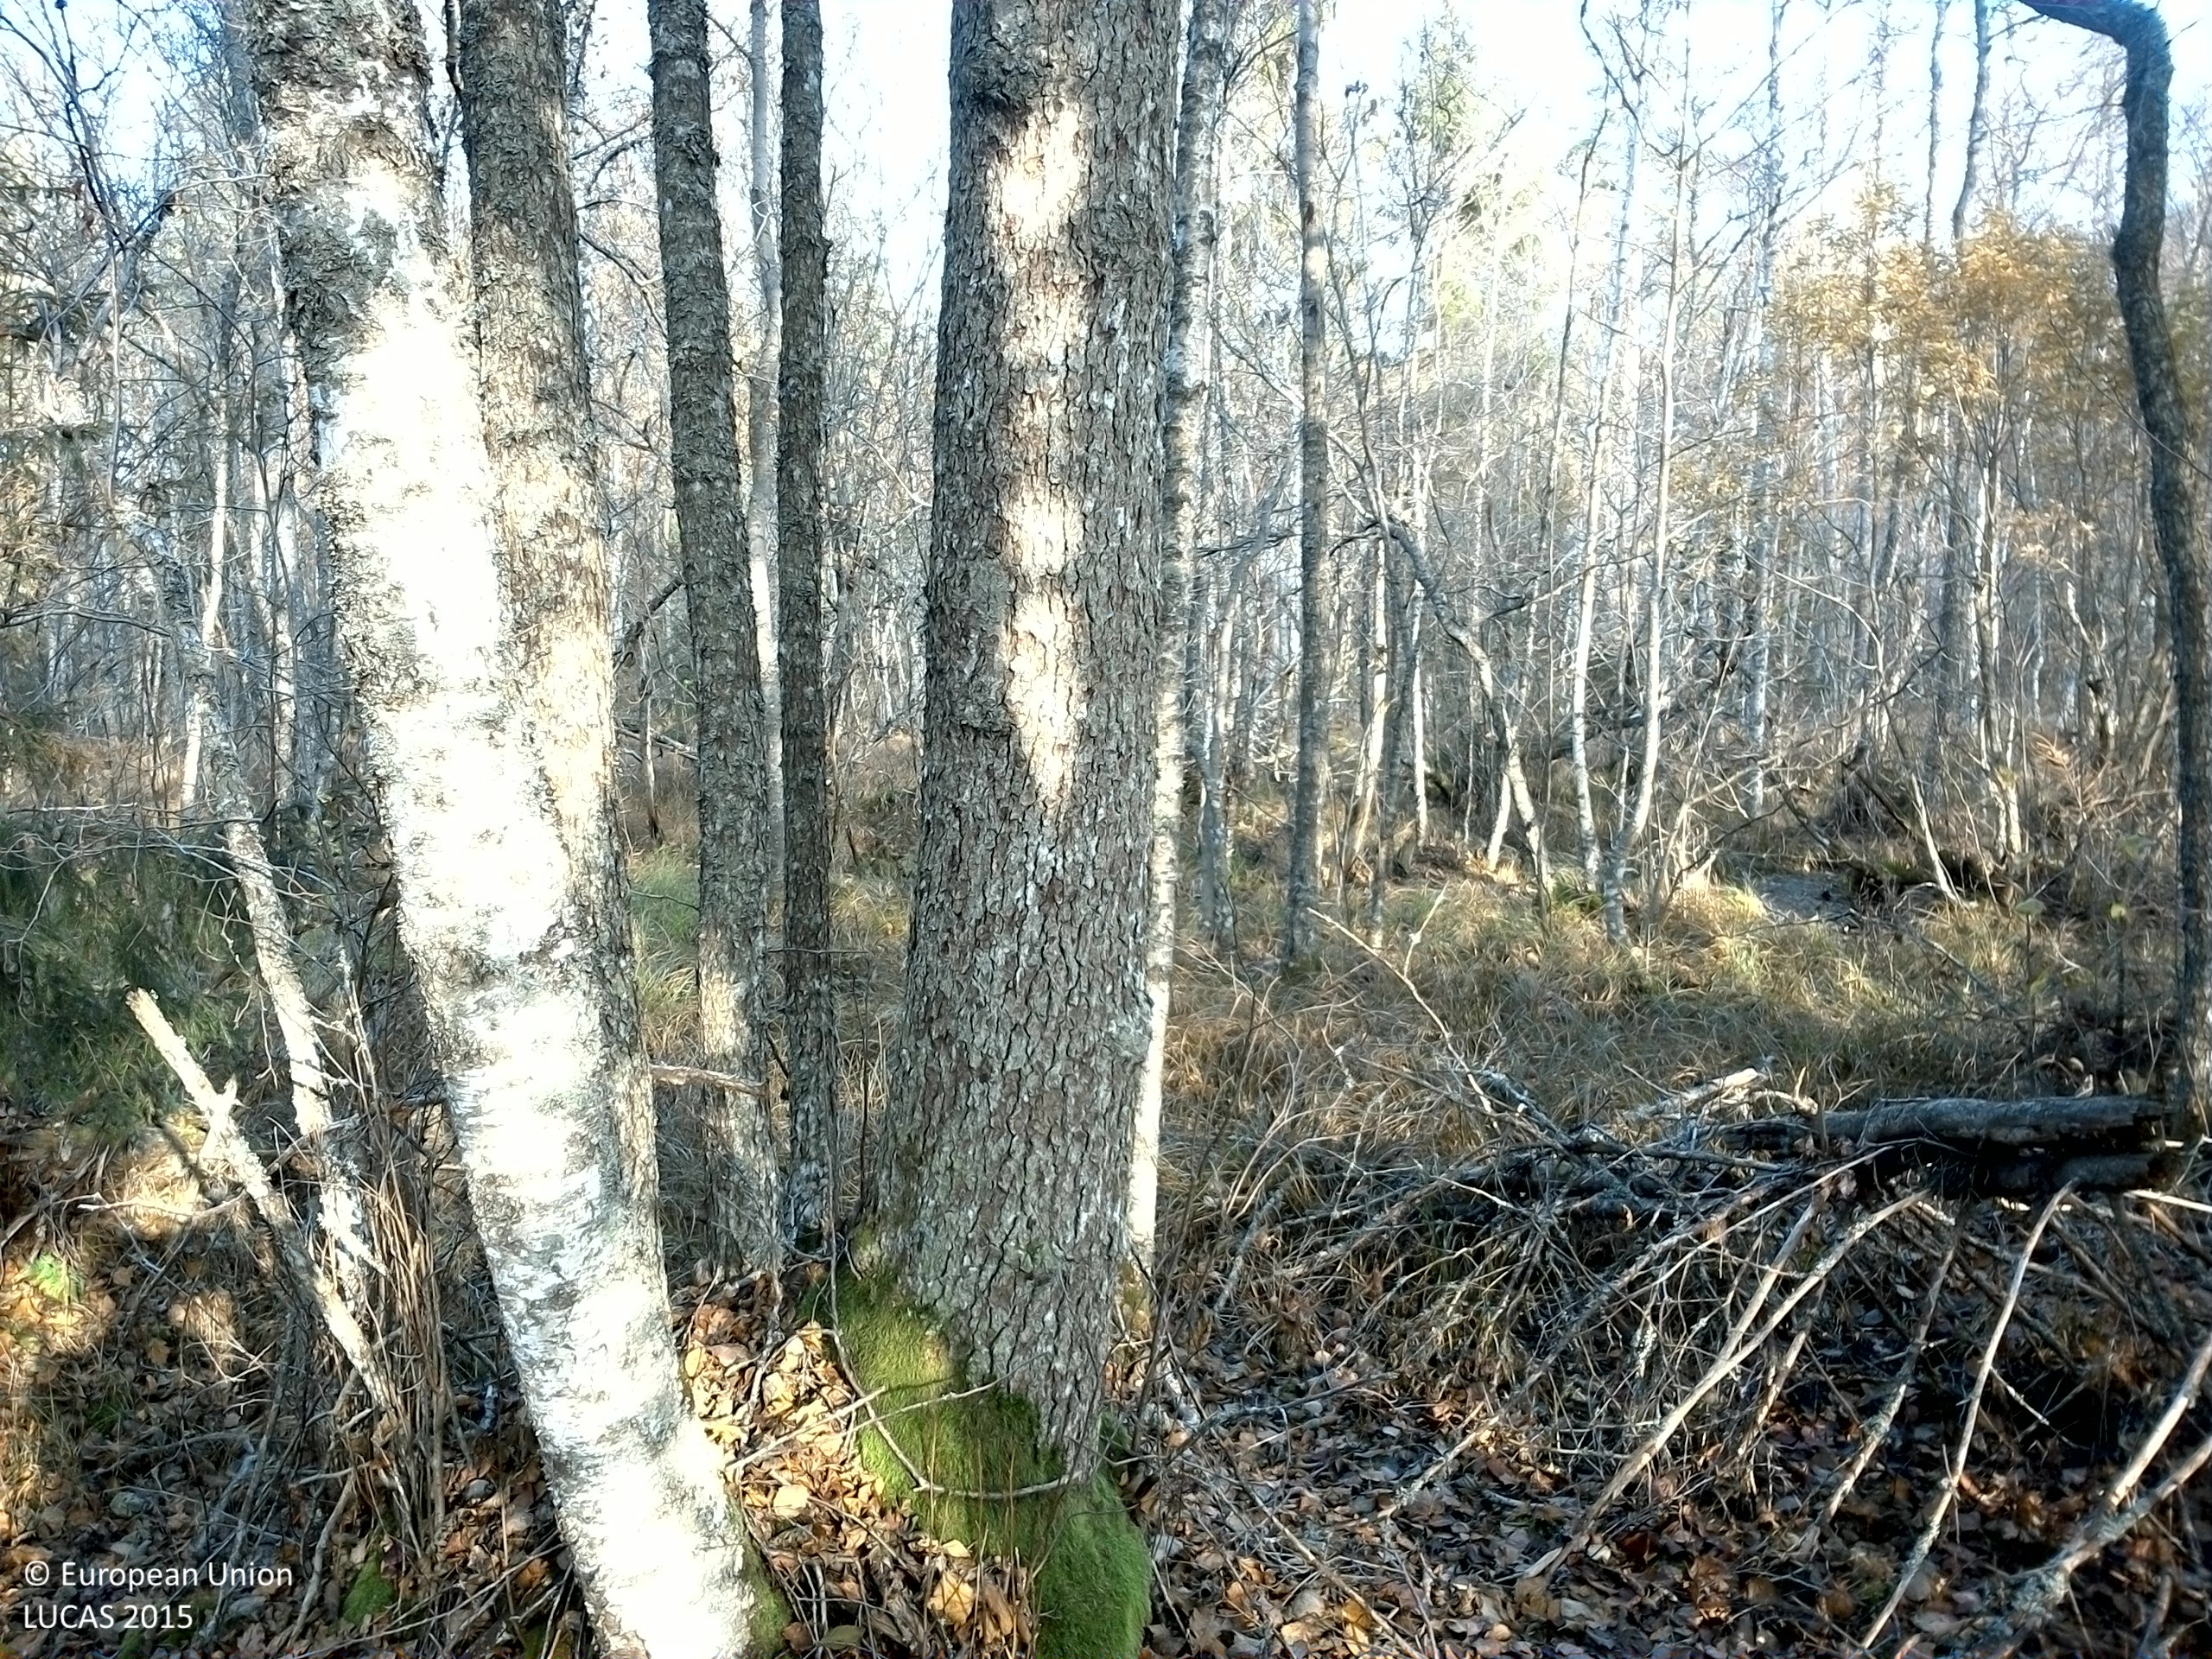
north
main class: Woodland
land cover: Broadleaved woodland
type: hemiboreal forest and nemoral coniferous forest and mixed broadleaved-coniferous forest
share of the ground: > 75 %
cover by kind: broadleaved forest trees 75 %, herbaceous plants 10 %, lichens and mosses 10 %, coniferous forest trees 5 %
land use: Forestry
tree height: > 5 m
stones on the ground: < 10 %
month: October
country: SE
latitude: 59.4091
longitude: 17.0234
